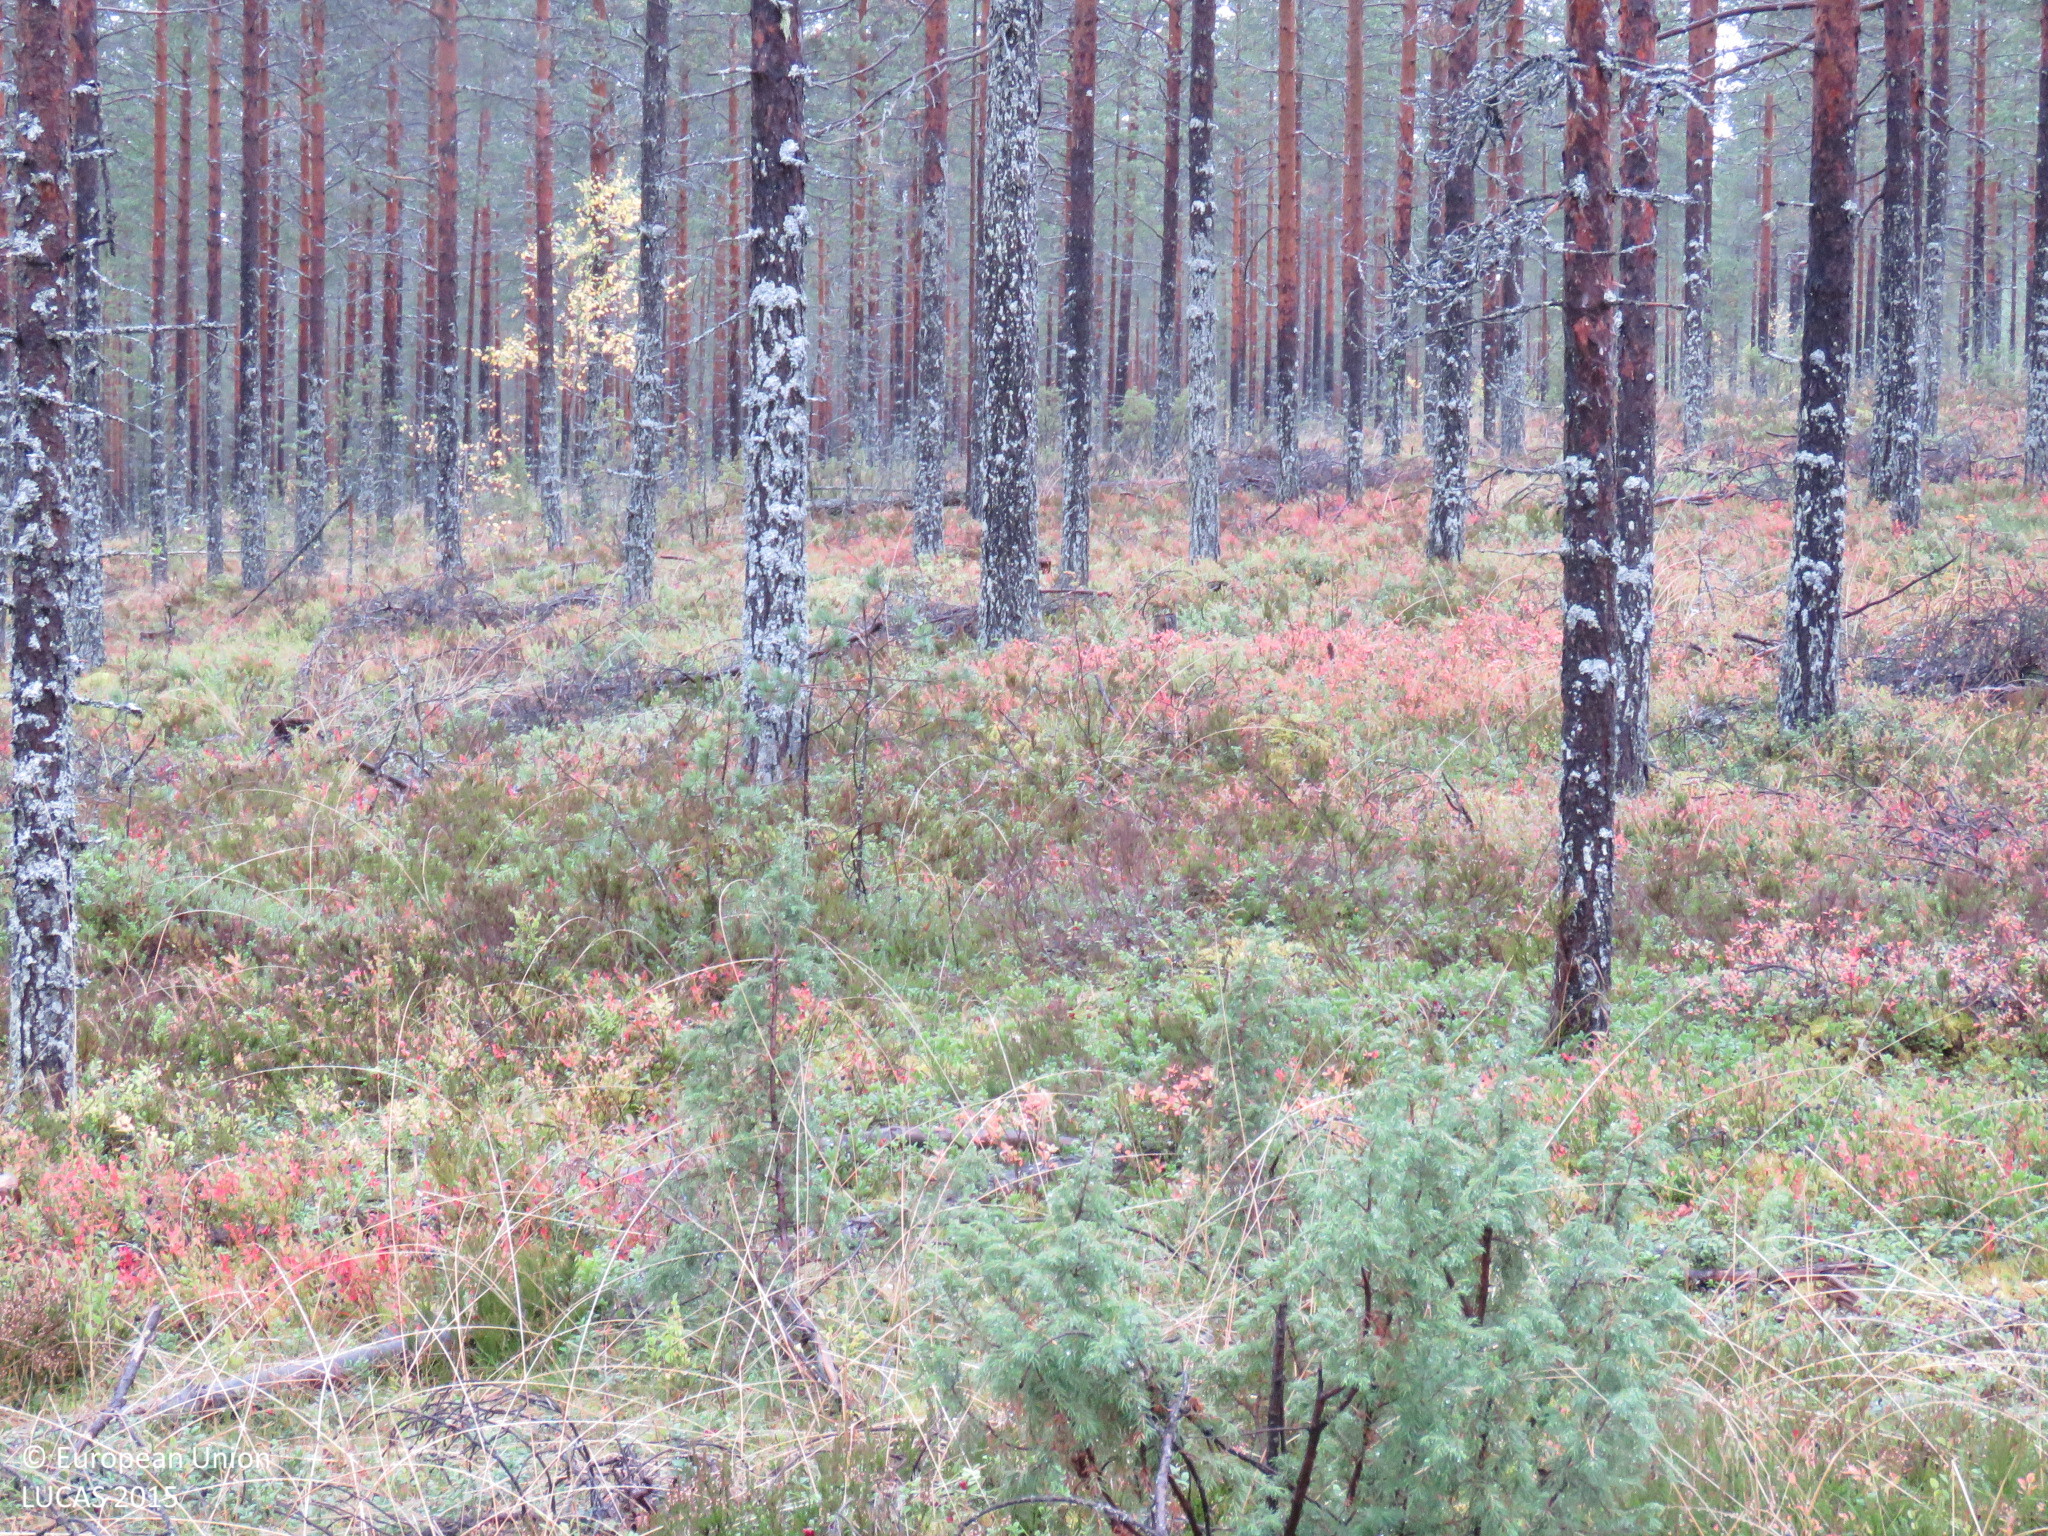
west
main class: Woodland
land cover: Pine dominated coniferous woodland
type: boreal forest
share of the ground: > 75 %
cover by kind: coniferous forest trees 70 %, shrubs 20 %, broadleaved forest trees 5 %, lichens and mosses 5 %
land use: Forestry
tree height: > 5 m
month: September
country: FI
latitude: 65.1181
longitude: 26.7052
